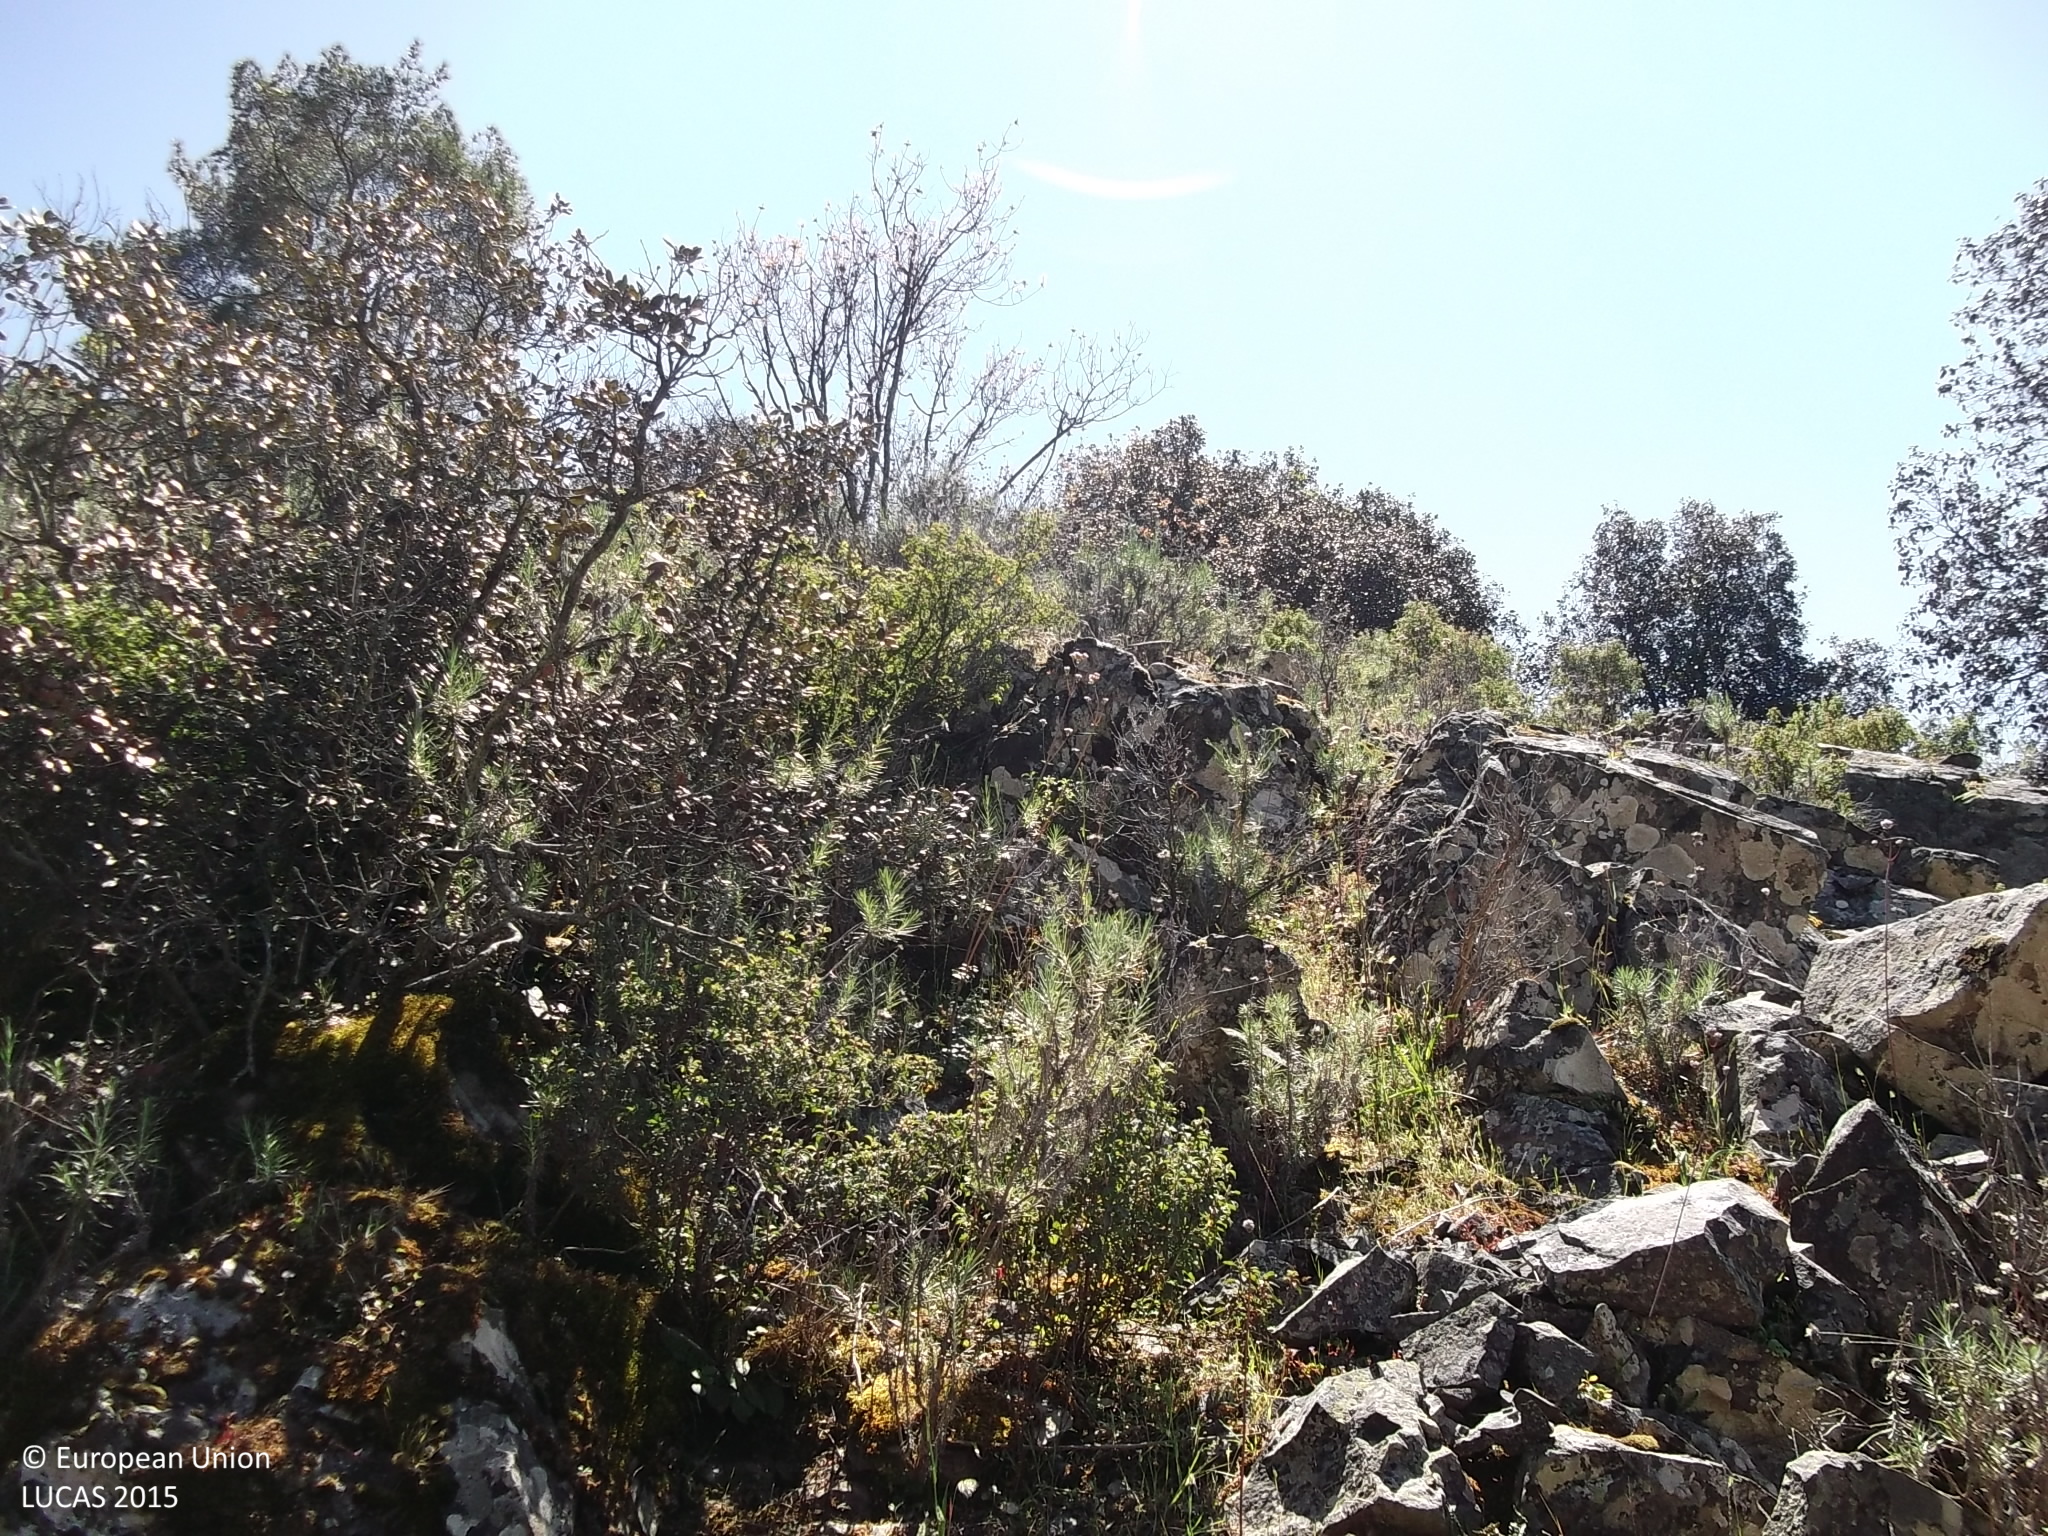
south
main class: Shrubland
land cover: Shrubland with sparse tree cover
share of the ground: > 75 %
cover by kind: shrubs 75 %, consolidated bare surface 10 %, unconsolidated bare surface 10 %, coniferous forest trees 5 %
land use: Semi-natural and natural areas not in use
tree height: > 5 m
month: April
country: CY
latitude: 34.9178
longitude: 33.1752
